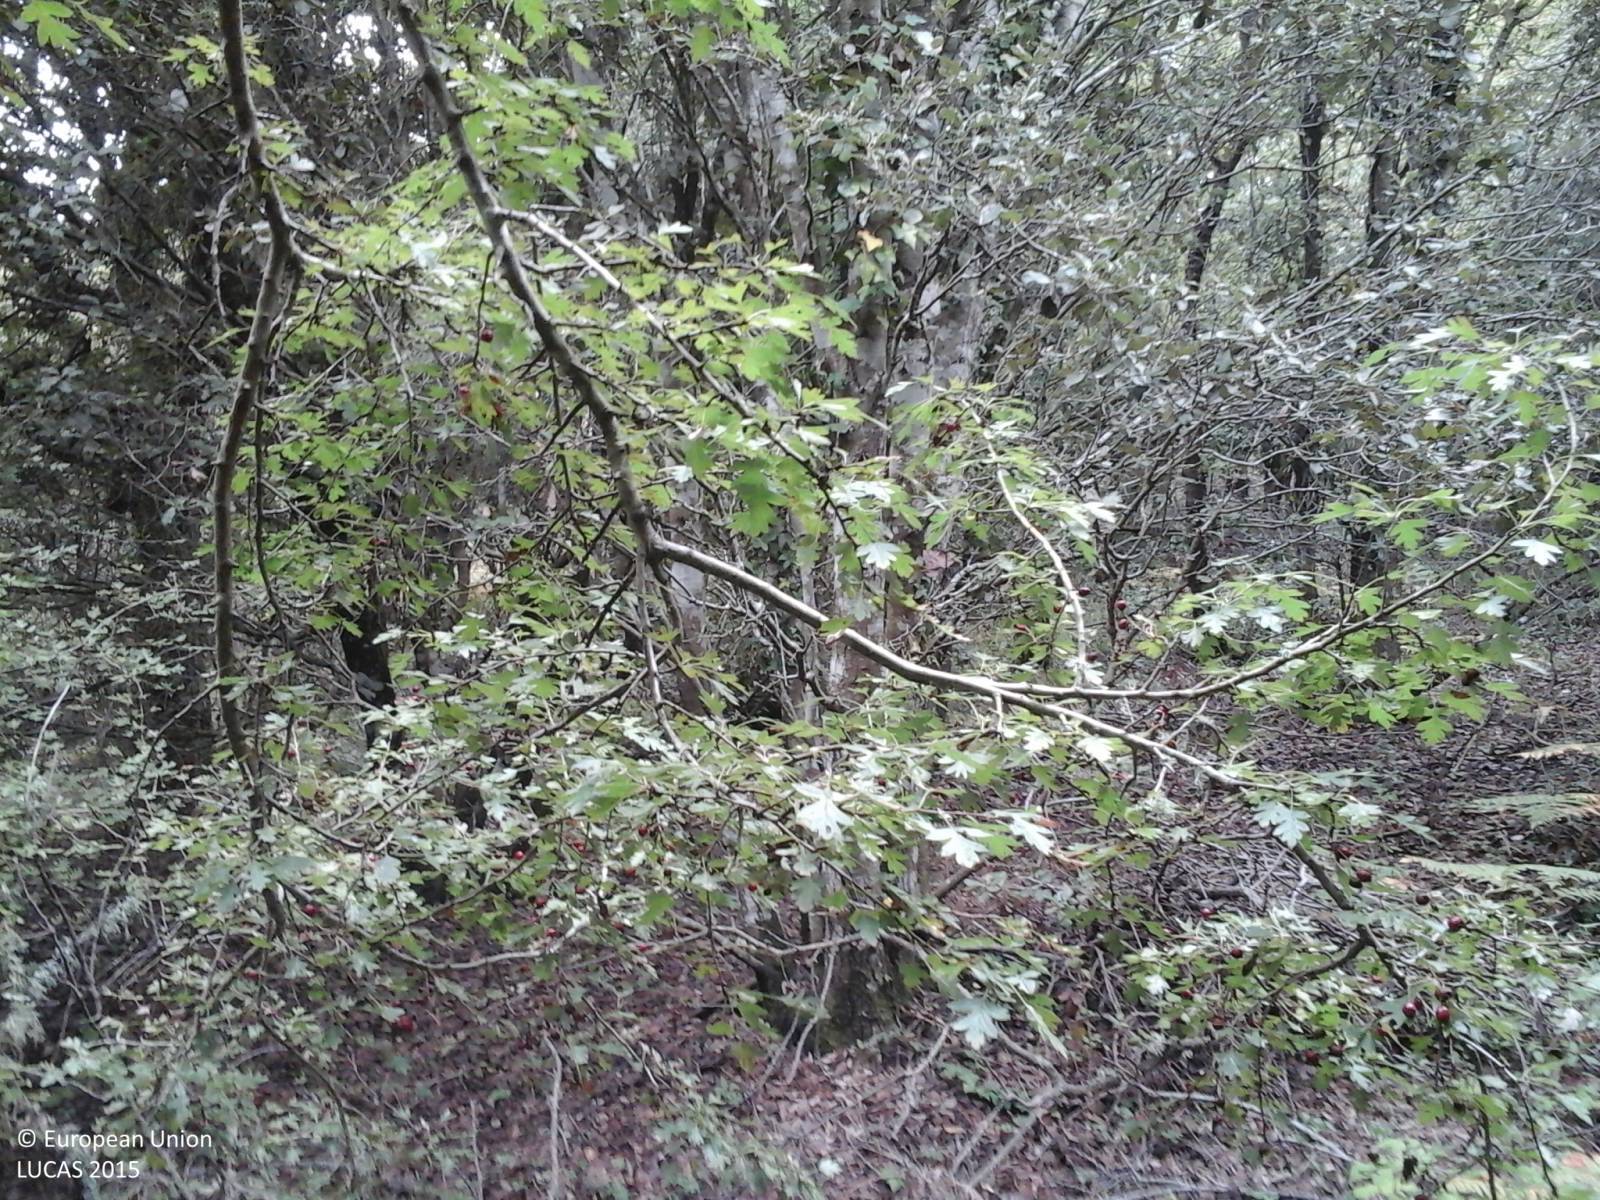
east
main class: Woodland
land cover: Broadleaved woodland
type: broadleaved evergreen forest
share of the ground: > 75 %
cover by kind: broadleaved forest trees 100 %
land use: Forestry
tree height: > 5 m
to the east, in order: Broadleaved woodland; Grassland without tree/shrub cover; Dry stone walls; Broadleaved woodland; Grass margins; Paved roads, cycling and walking lanes; Shrubland without tree cover; Electric lines; Dry stone walls; Broadleaved woodland
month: September
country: IT
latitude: 40.2403
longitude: 8.6787
